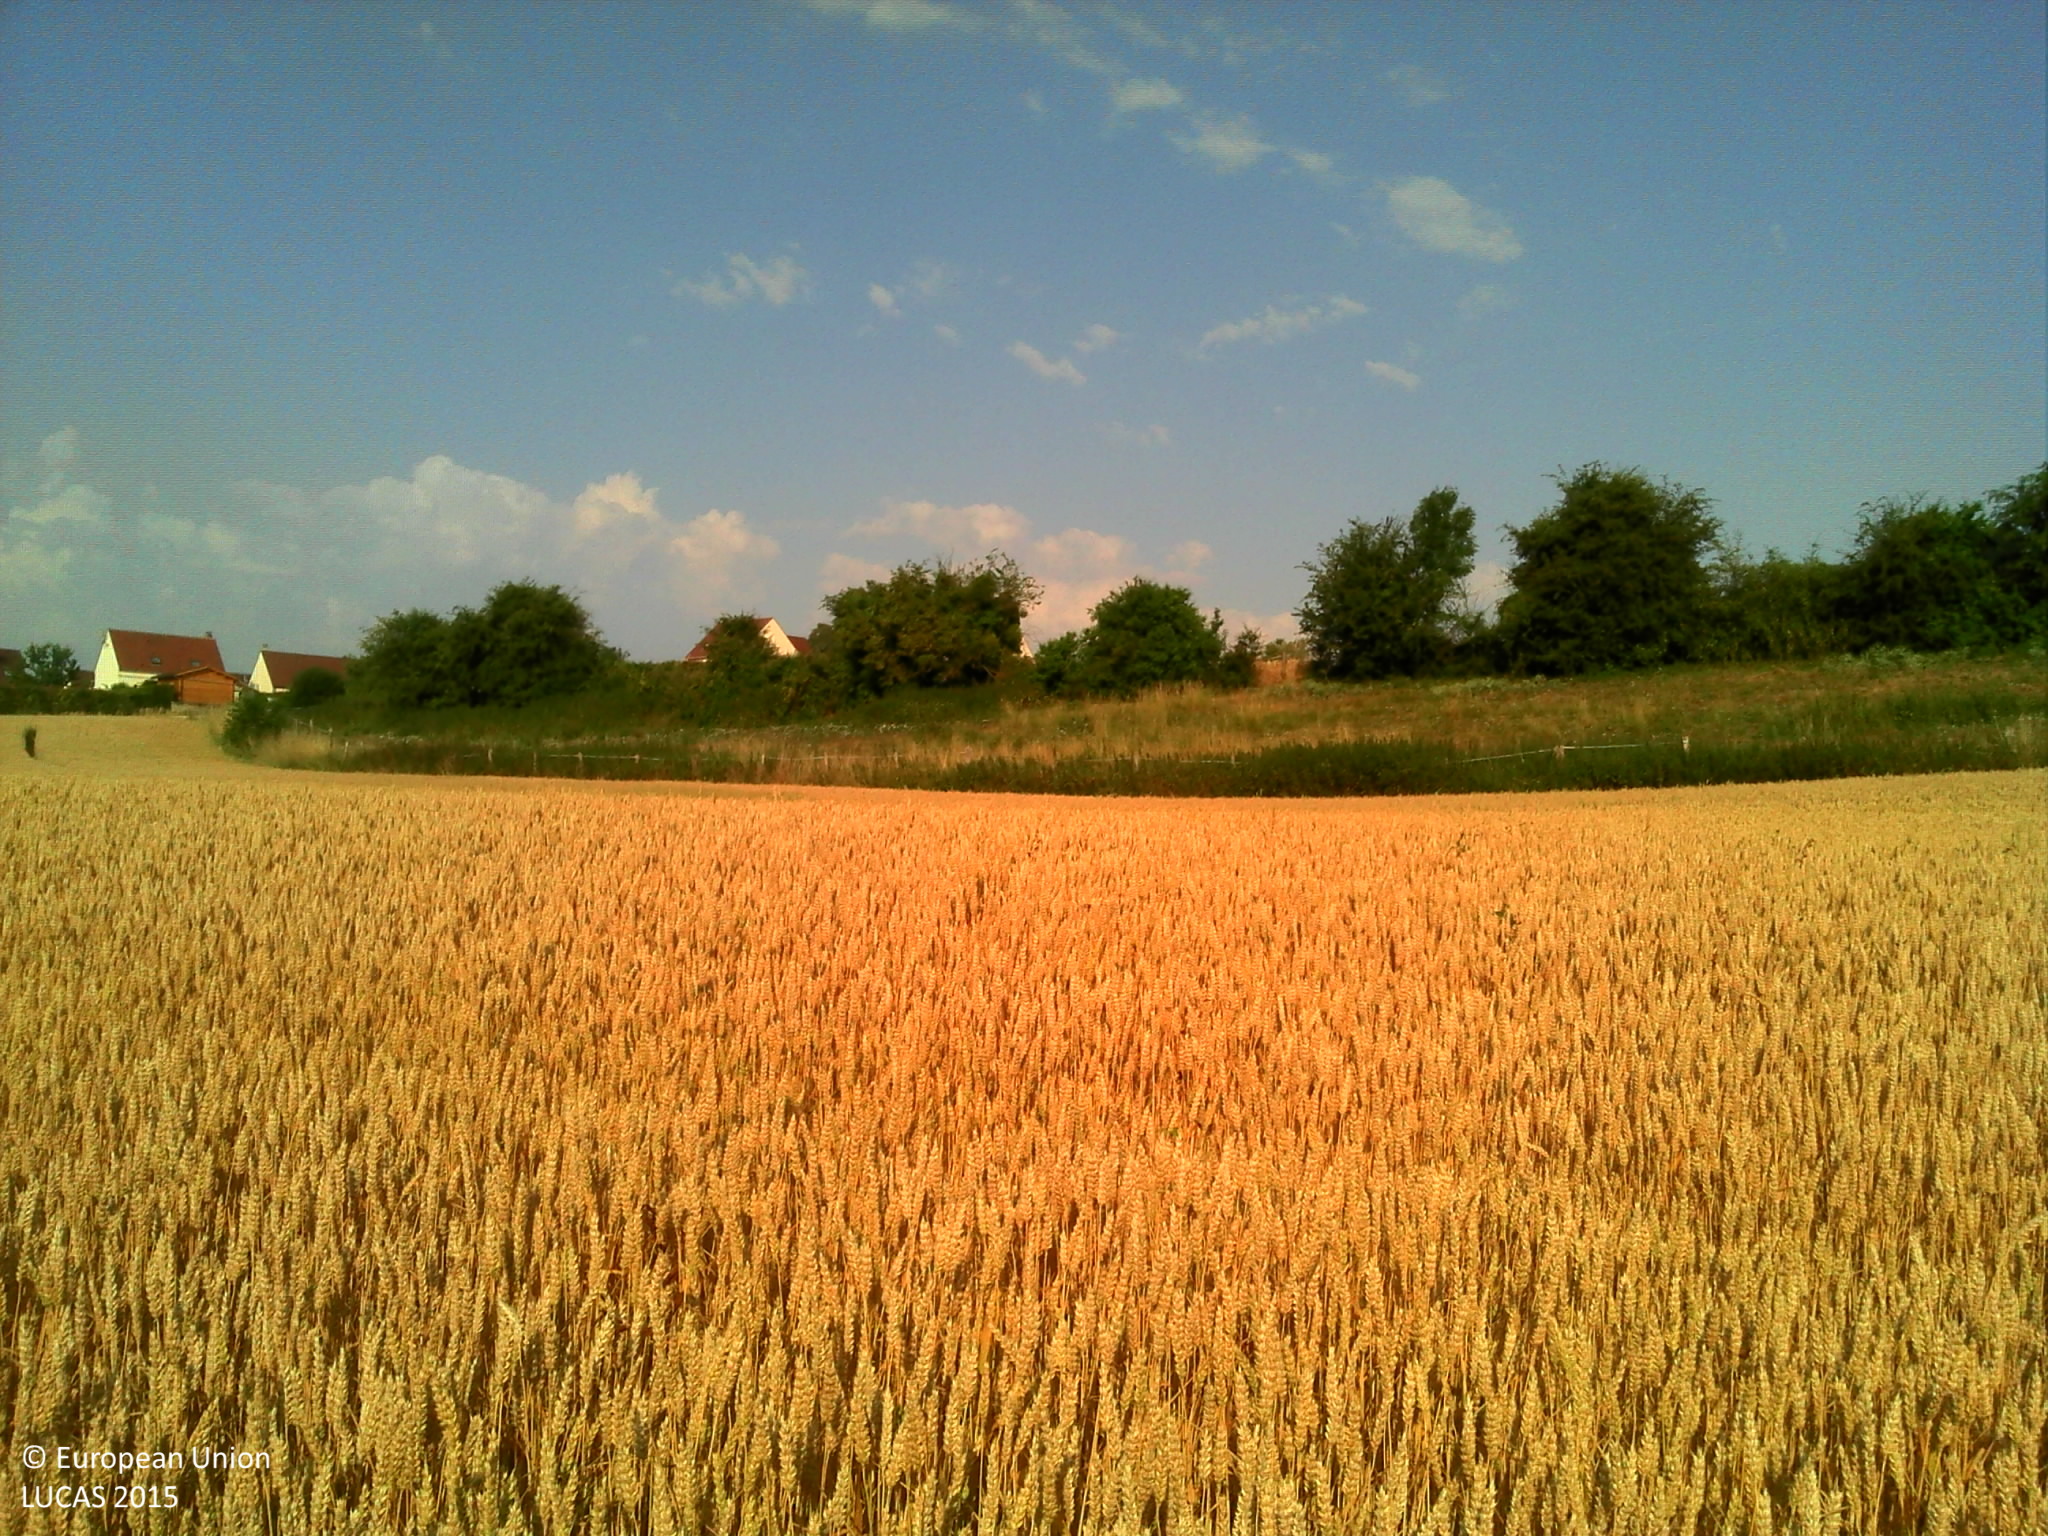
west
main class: Cropland
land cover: Common wheat
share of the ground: > 75 %
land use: Agriculture (excluding fallow land and kitchen gardens)
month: July
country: FR
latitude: 49.3080
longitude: 2.5475
